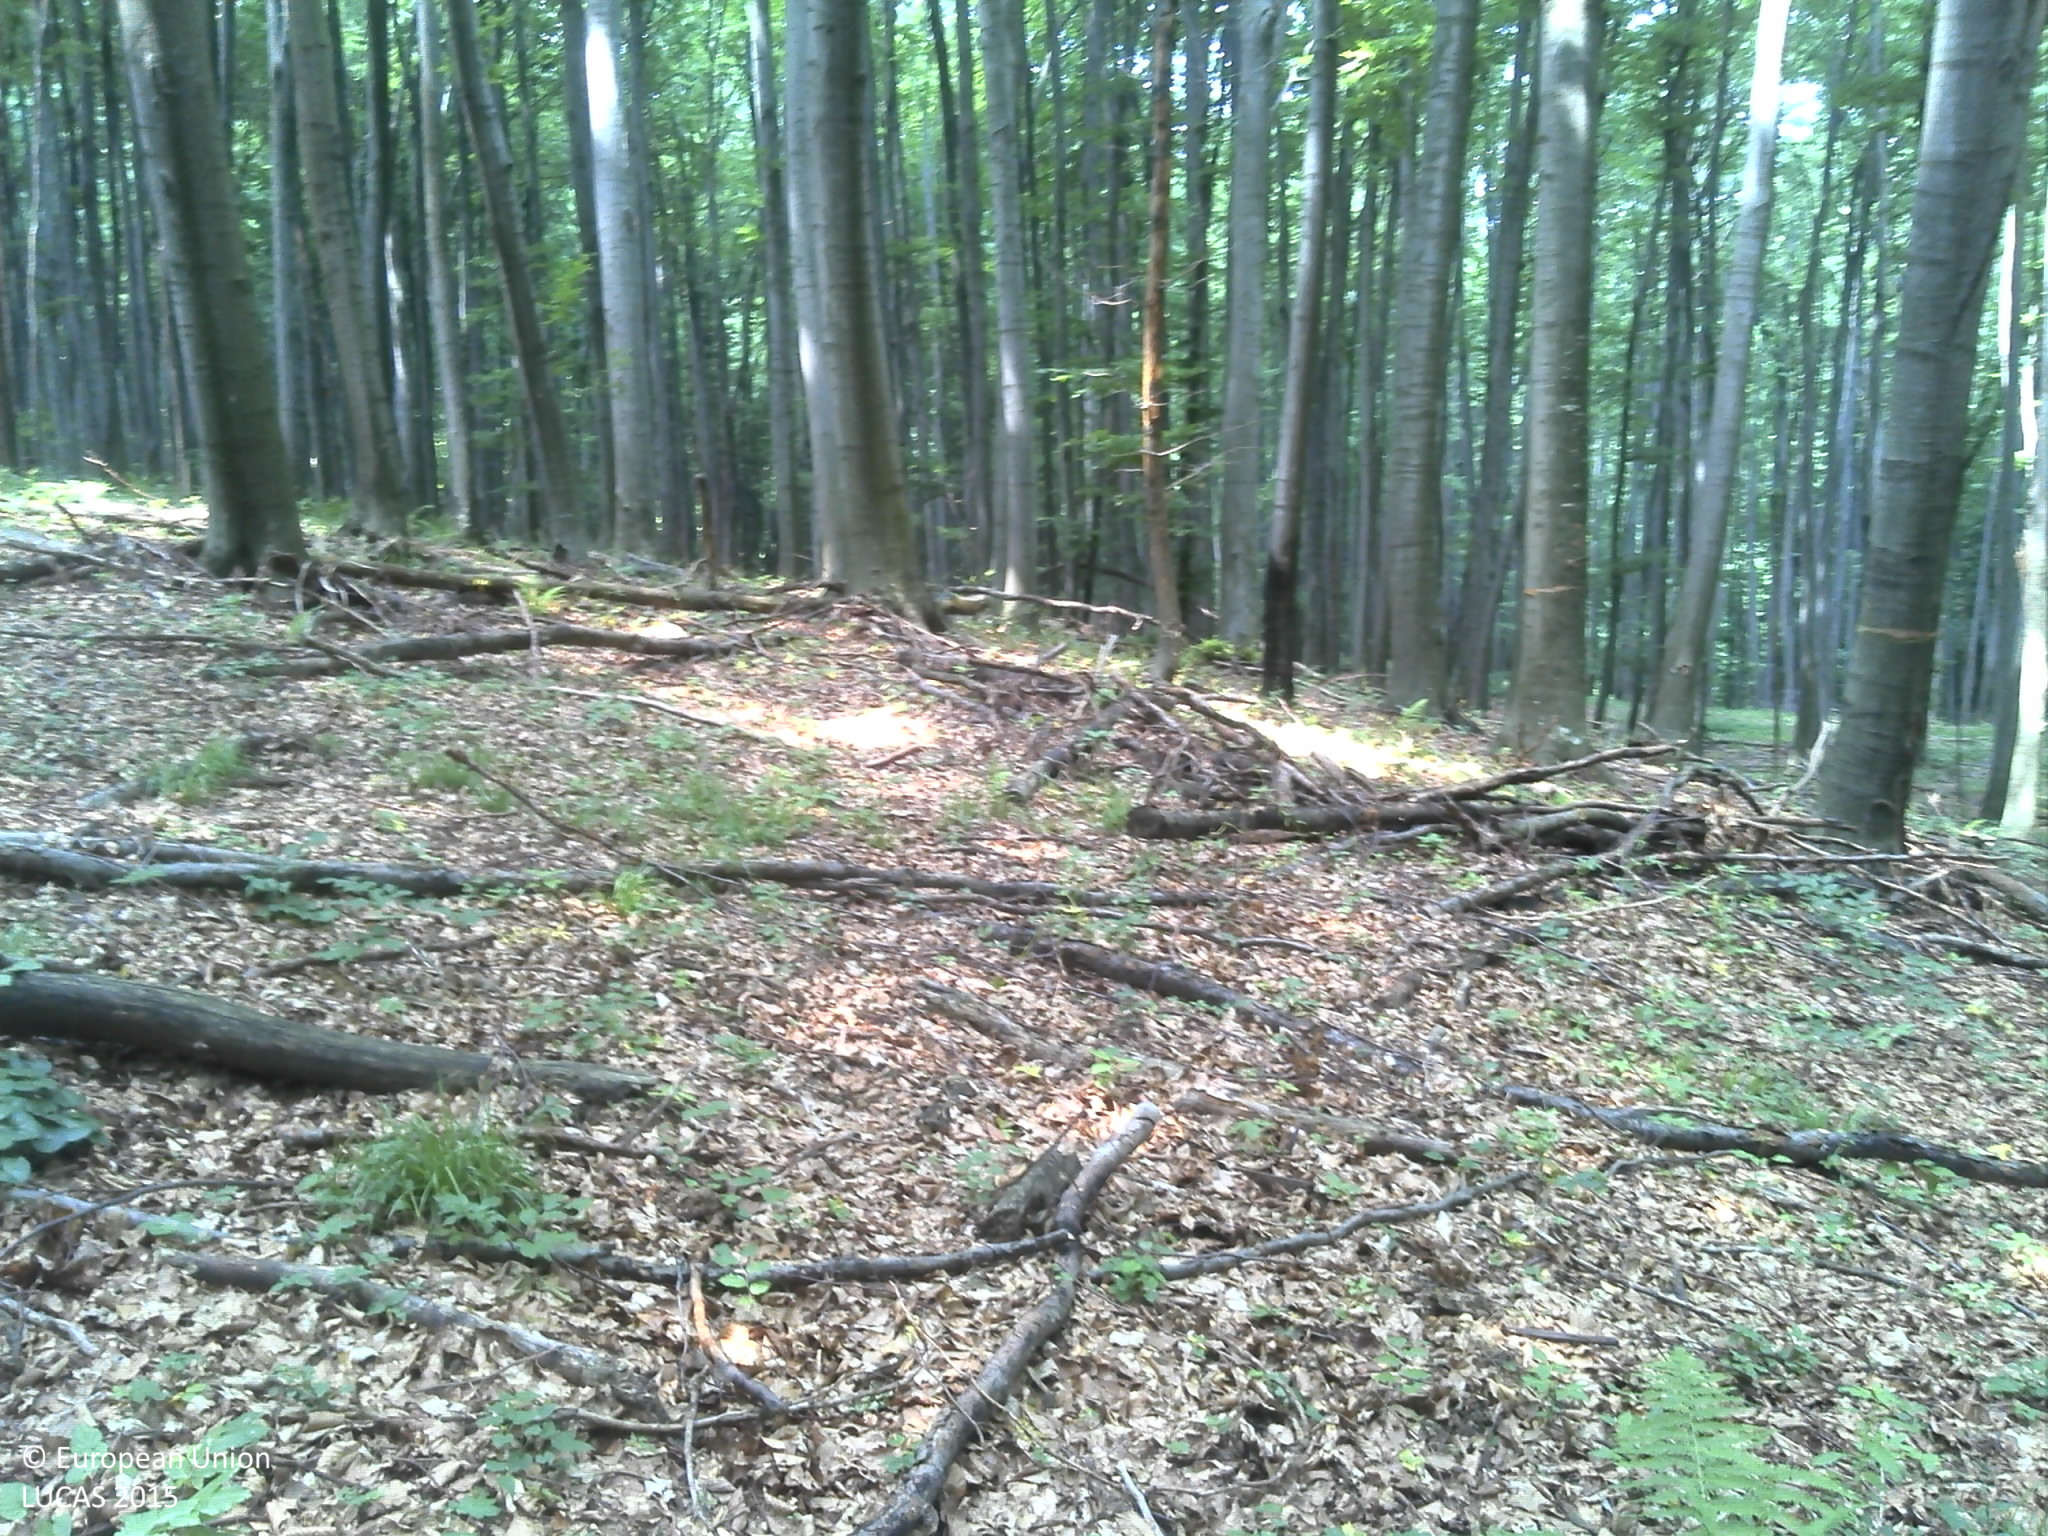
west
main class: Woodland
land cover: Broadleaved woodland
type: beech forest
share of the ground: > 75 %
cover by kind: broadleaved forest trees 90 %, shrubs 5 %, herbaceous plants 5 %
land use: Forestry
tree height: > 5 m
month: June
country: HR
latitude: 45.6171
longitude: 17.5041
